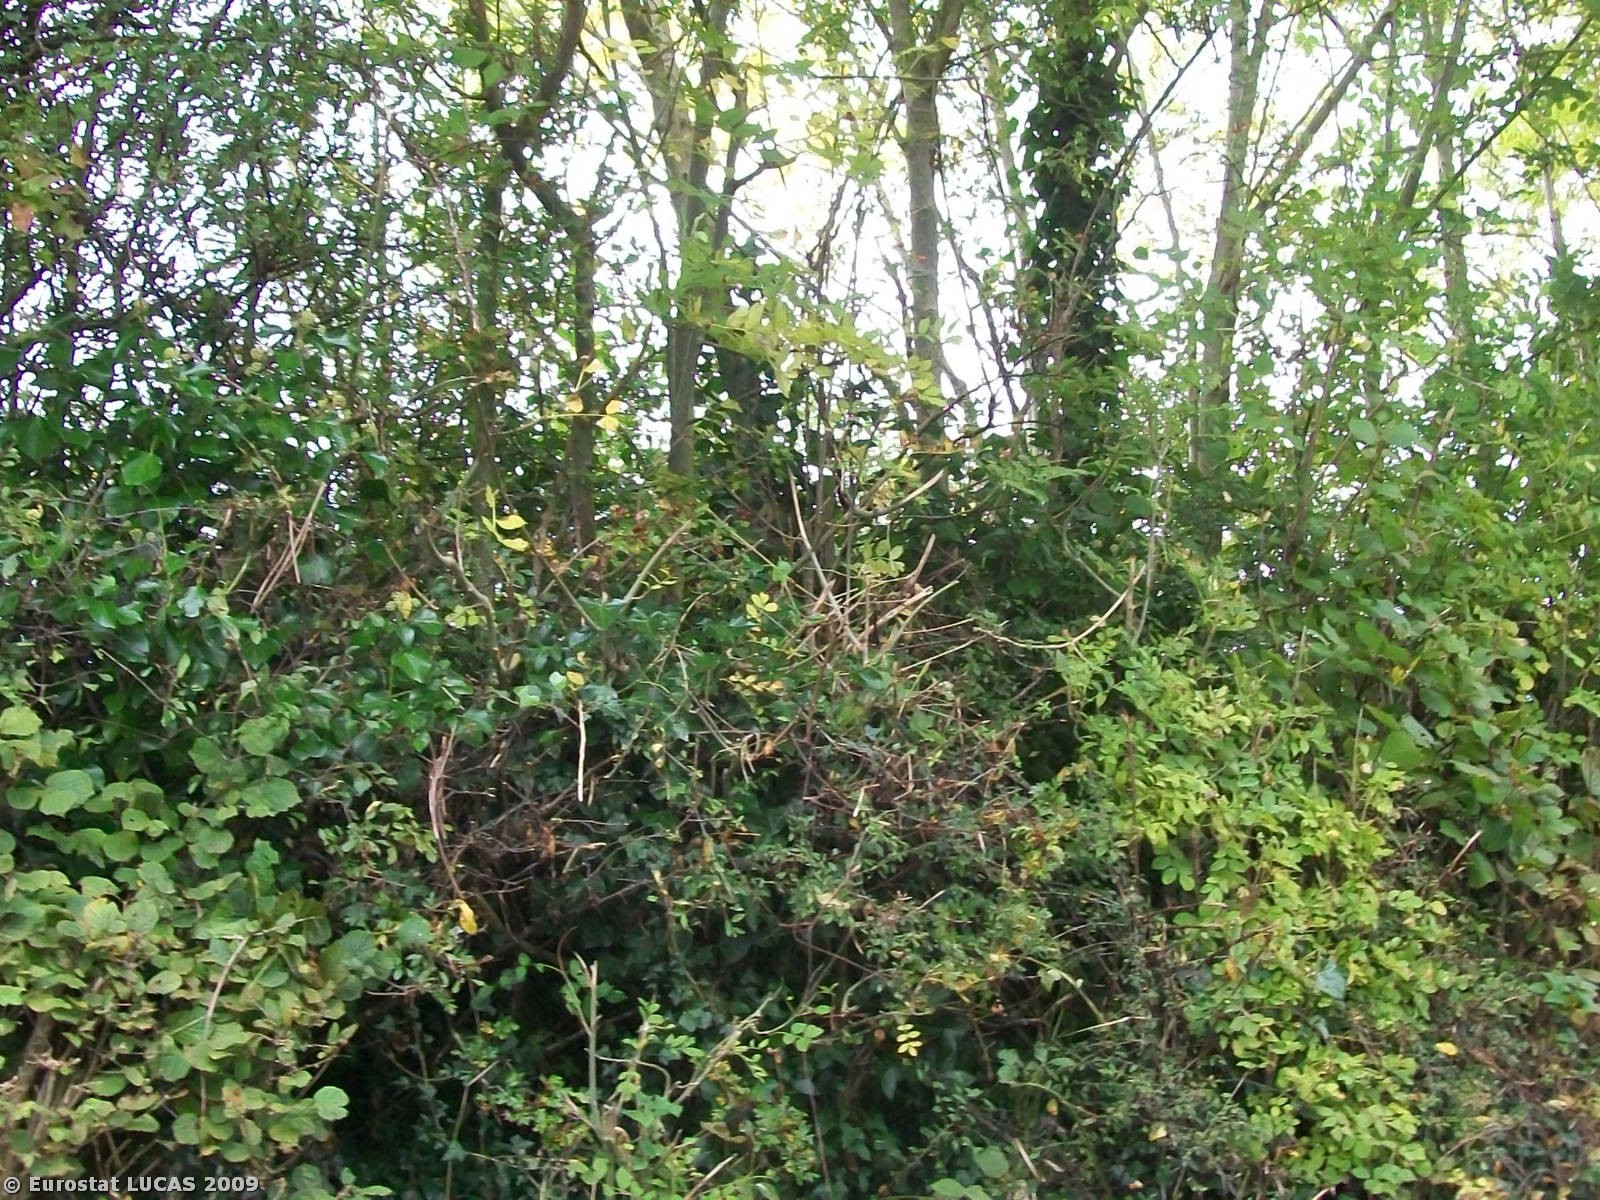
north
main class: Artificial land
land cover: Non built-up linear features
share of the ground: > 75 %
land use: Road transport
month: September
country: IE
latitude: 53.0235
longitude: -8.3005
